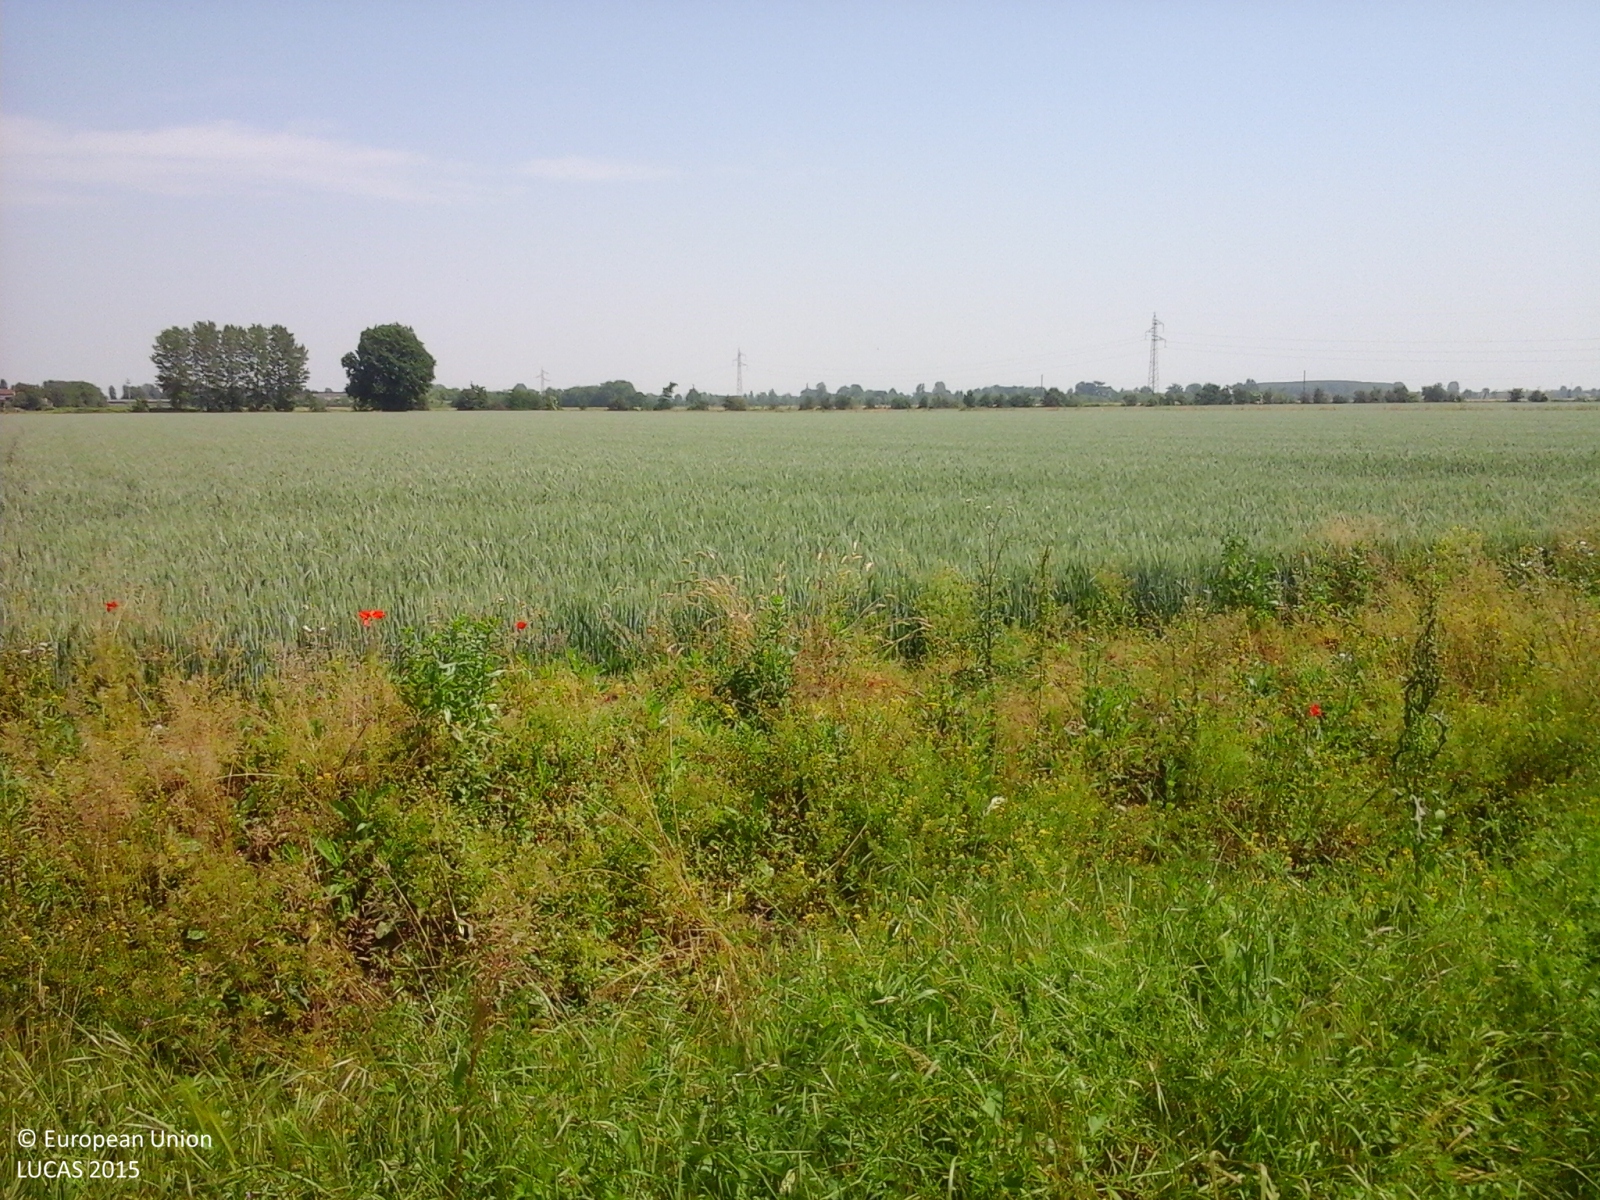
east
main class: Cropland
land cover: Common wheat
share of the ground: > 75 %
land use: Agriculture (excluding fallow land and kitchen gardens)
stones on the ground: 10 - 25 %
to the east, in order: Common wheat; Tracks; Ditches and canals; Grass margins; Common wheat
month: May
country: IT
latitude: 45.2678
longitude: 9.3003
